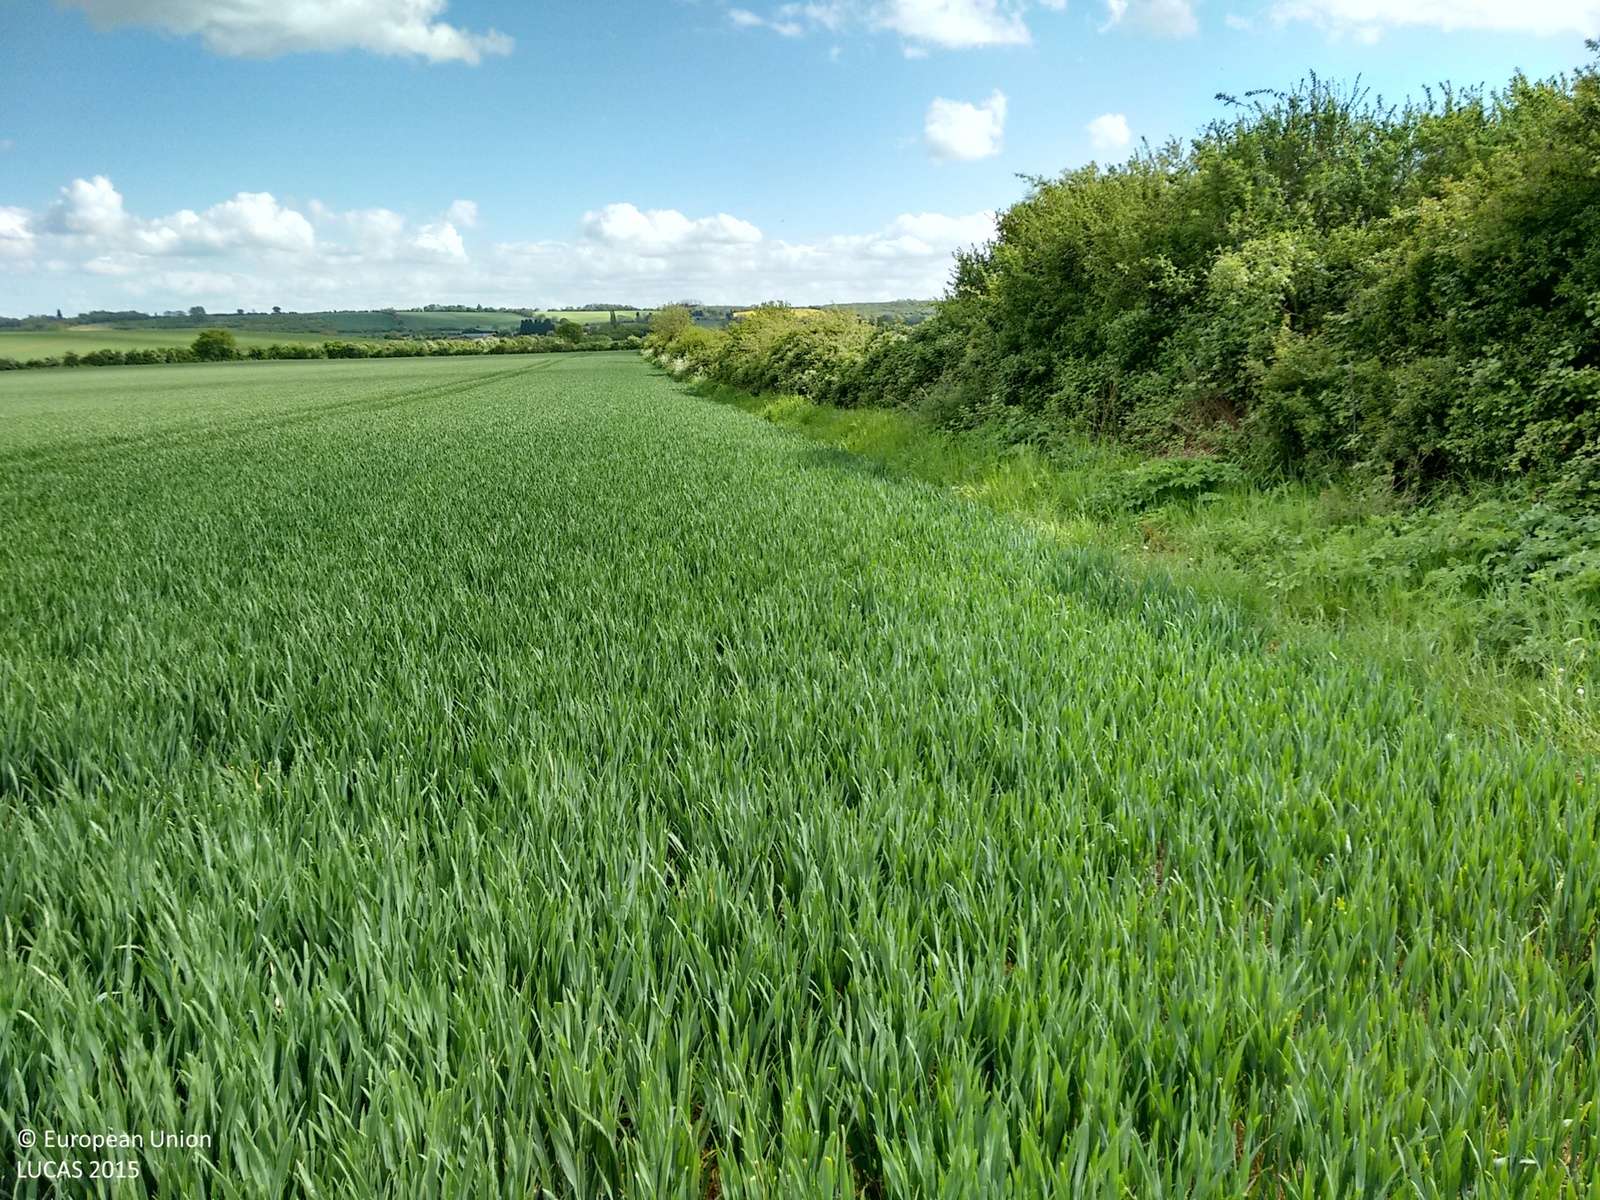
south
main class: Cropland
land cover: Common wheat
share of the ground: > 75 %
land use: Agriculture (excluding fallow land and kitchen gardens)
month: May
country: GB
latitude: 52.0763
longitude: -0.4703
